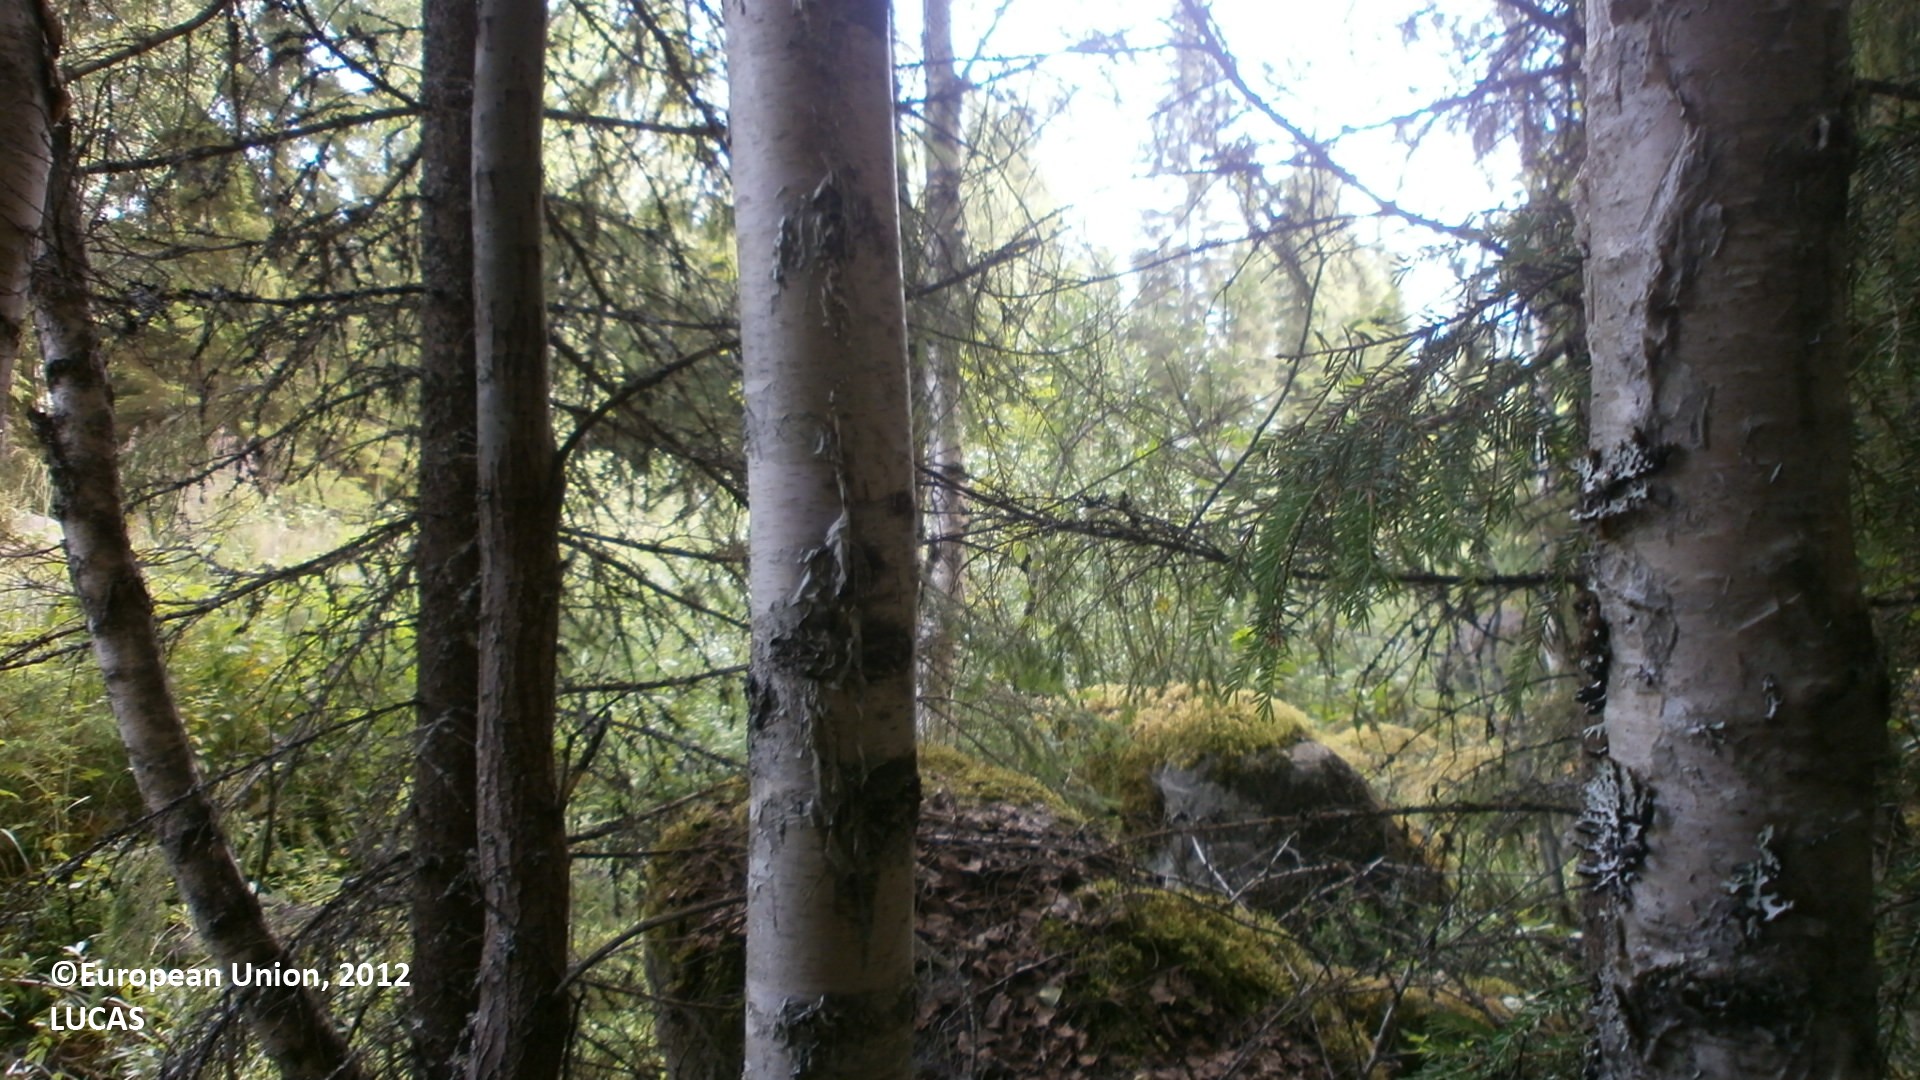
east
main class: Woodland
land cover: Spruce dominated mixed woodland
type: boreal forest
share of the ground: > 75 %
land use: Forestry
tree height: > 5 m
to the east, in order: Spruce dominated mixed woodland; Ditches and canals; Grassland with sparse tree/shrub cover; Tracks; Grassland with sparse tree/shrub cover; Ditches and canals; Spruce dominated mixed woodland; Ditches and canals; Spruce dominated mixed woodland; Ditches and canals; Spruce dominated mixed woodland; Ditches and canals; Pine dominated mixed woodland; Pine dominated coniferous woodland; Ditches and canals; Pine dominated mixed woodland; Broadleaved woodland
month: July
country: FI
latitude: 64.0230
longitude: 24.2920
